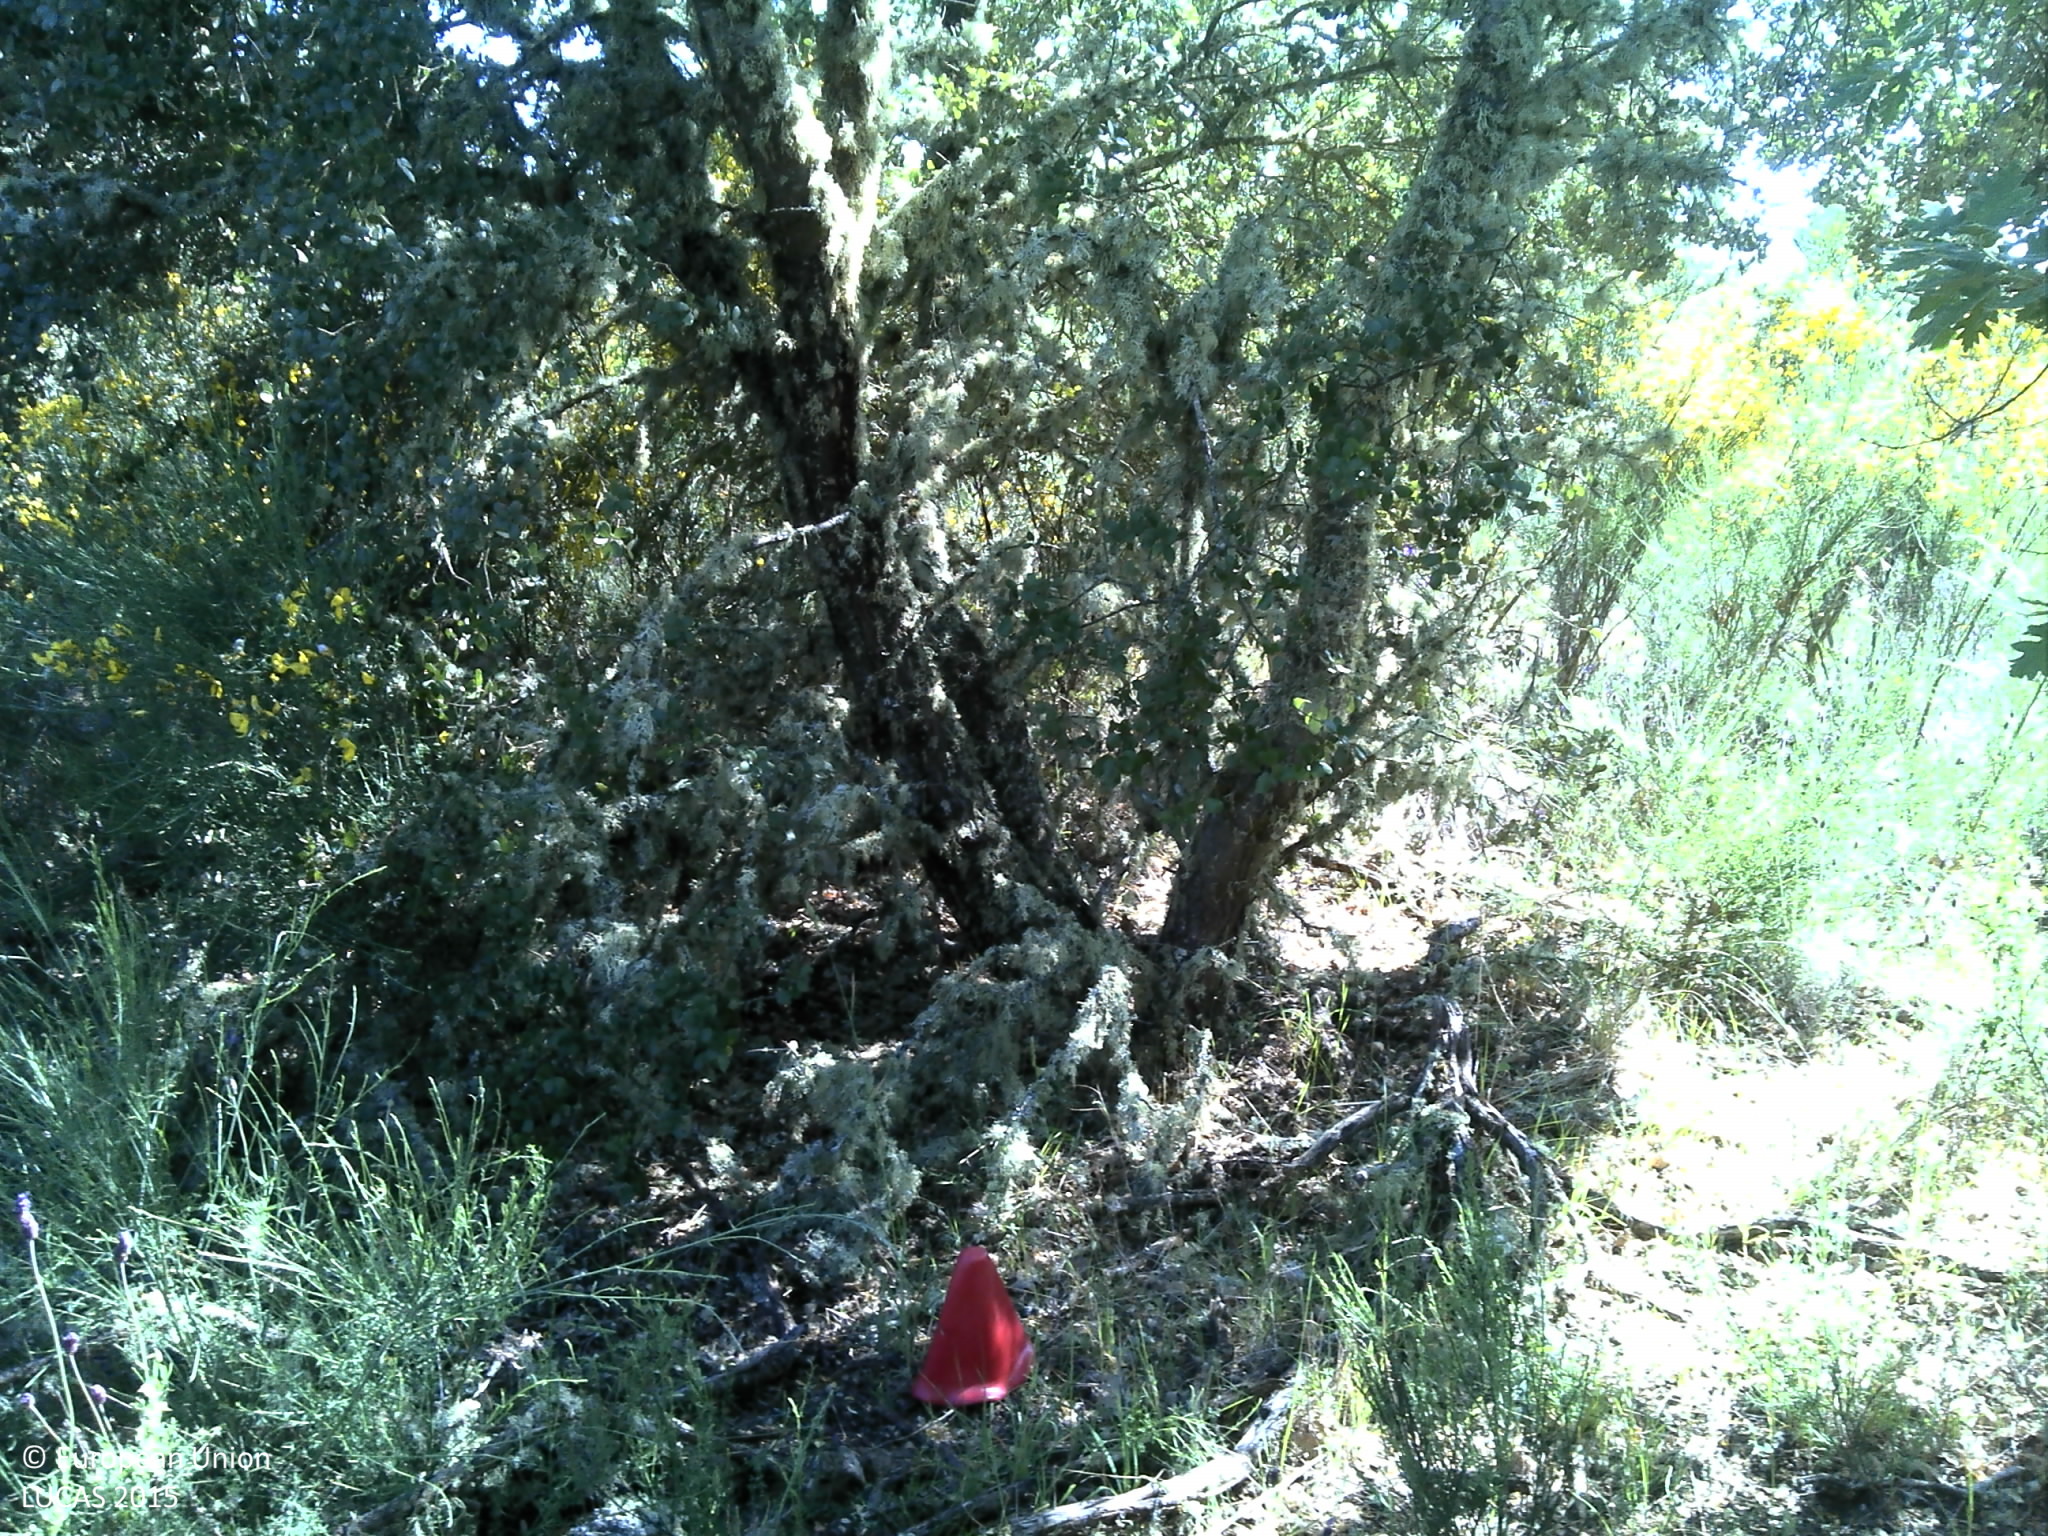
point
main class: Woodland
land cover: Broadleaved woodland
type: broadleaved evergreen forest
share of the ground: 25 - 50 %
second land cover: Shrubland without tree cover
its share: 25 - 50 %
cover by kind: shrubs 50 %, broadleaved forest trees 25 %, unconsolidated bare surface 15 %, herbaceous plants 10 %
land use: Forestry
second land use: Agriculture (excluding fallow land and kitchen gardens)
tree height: > 5 m
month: May
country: PT
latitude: 41.6153
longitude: -6.3132
